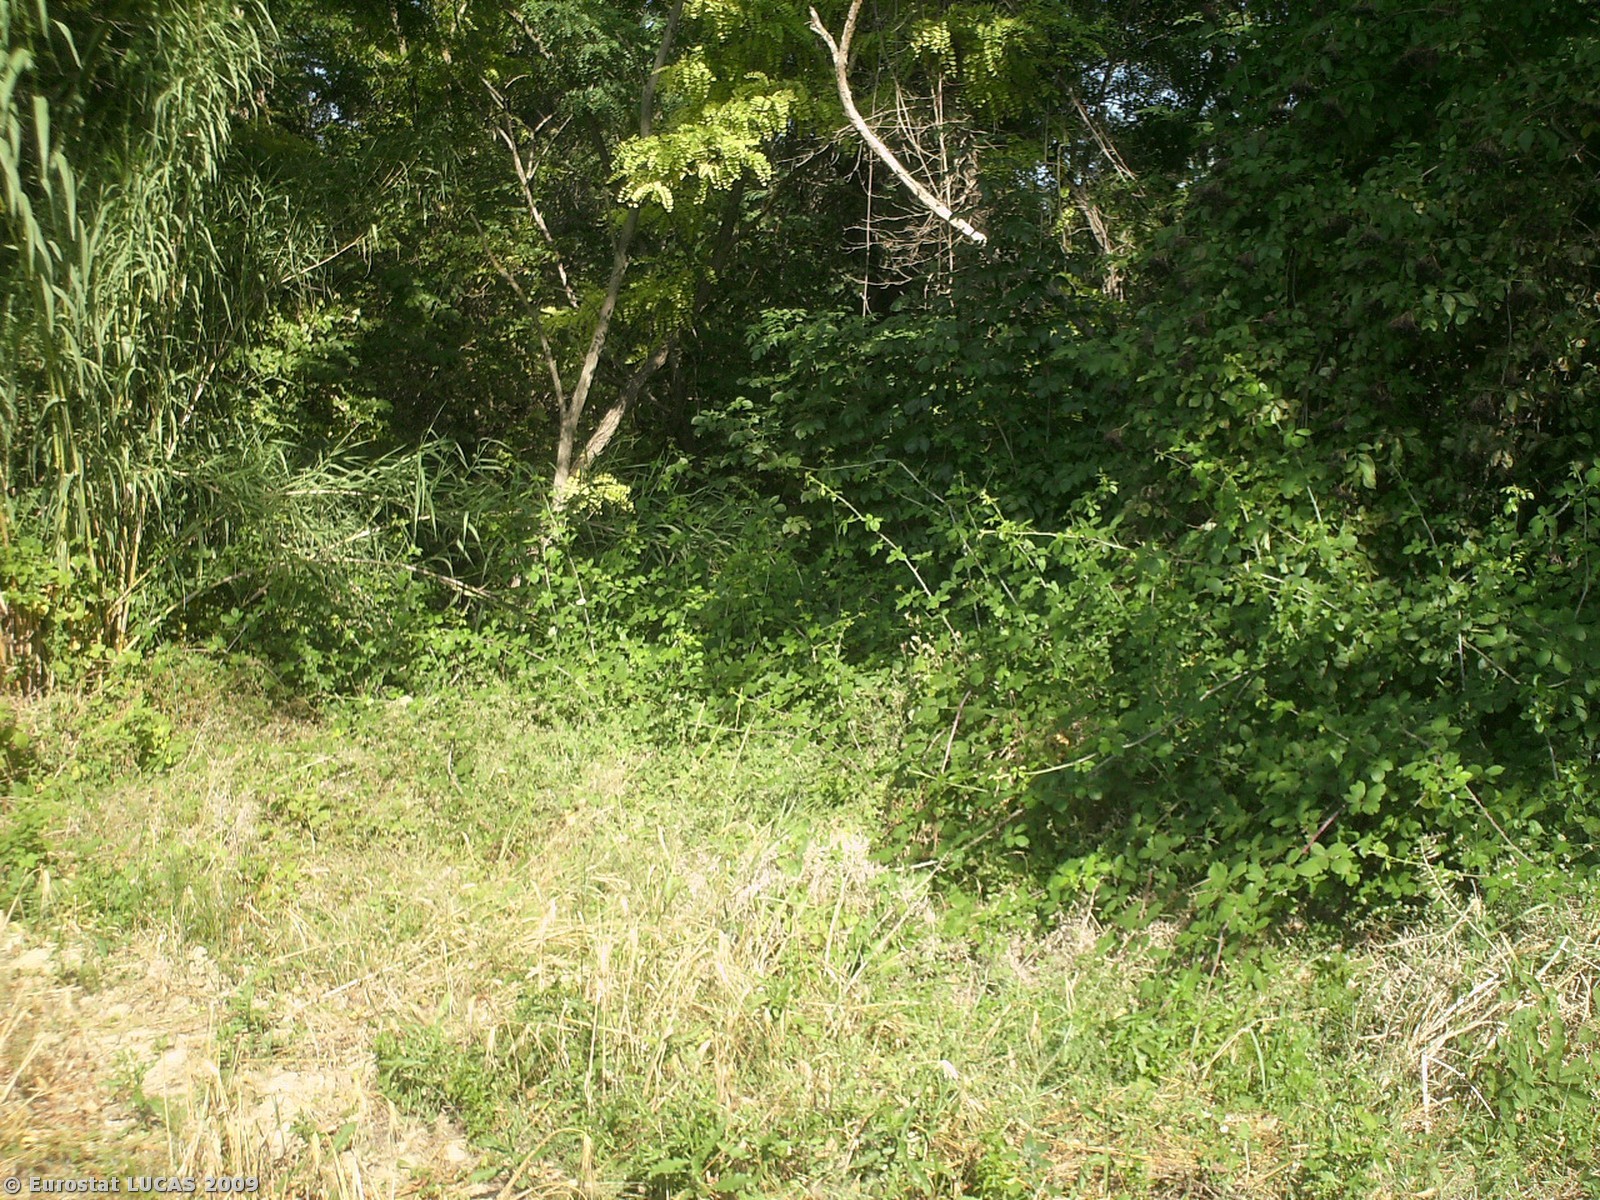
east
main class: Cropland
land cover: Durum wheat
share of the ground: < 10 %
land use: Agriculture (excluding fallow land and kitchen gardens)
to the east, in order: Durum wheat; Broadleaved woodland; Arable land (only in case pi); Shrubland with sparse tree cover; Arable land (only in case pi)
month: July
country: IT
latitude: 43.8244
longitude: 12.8407
